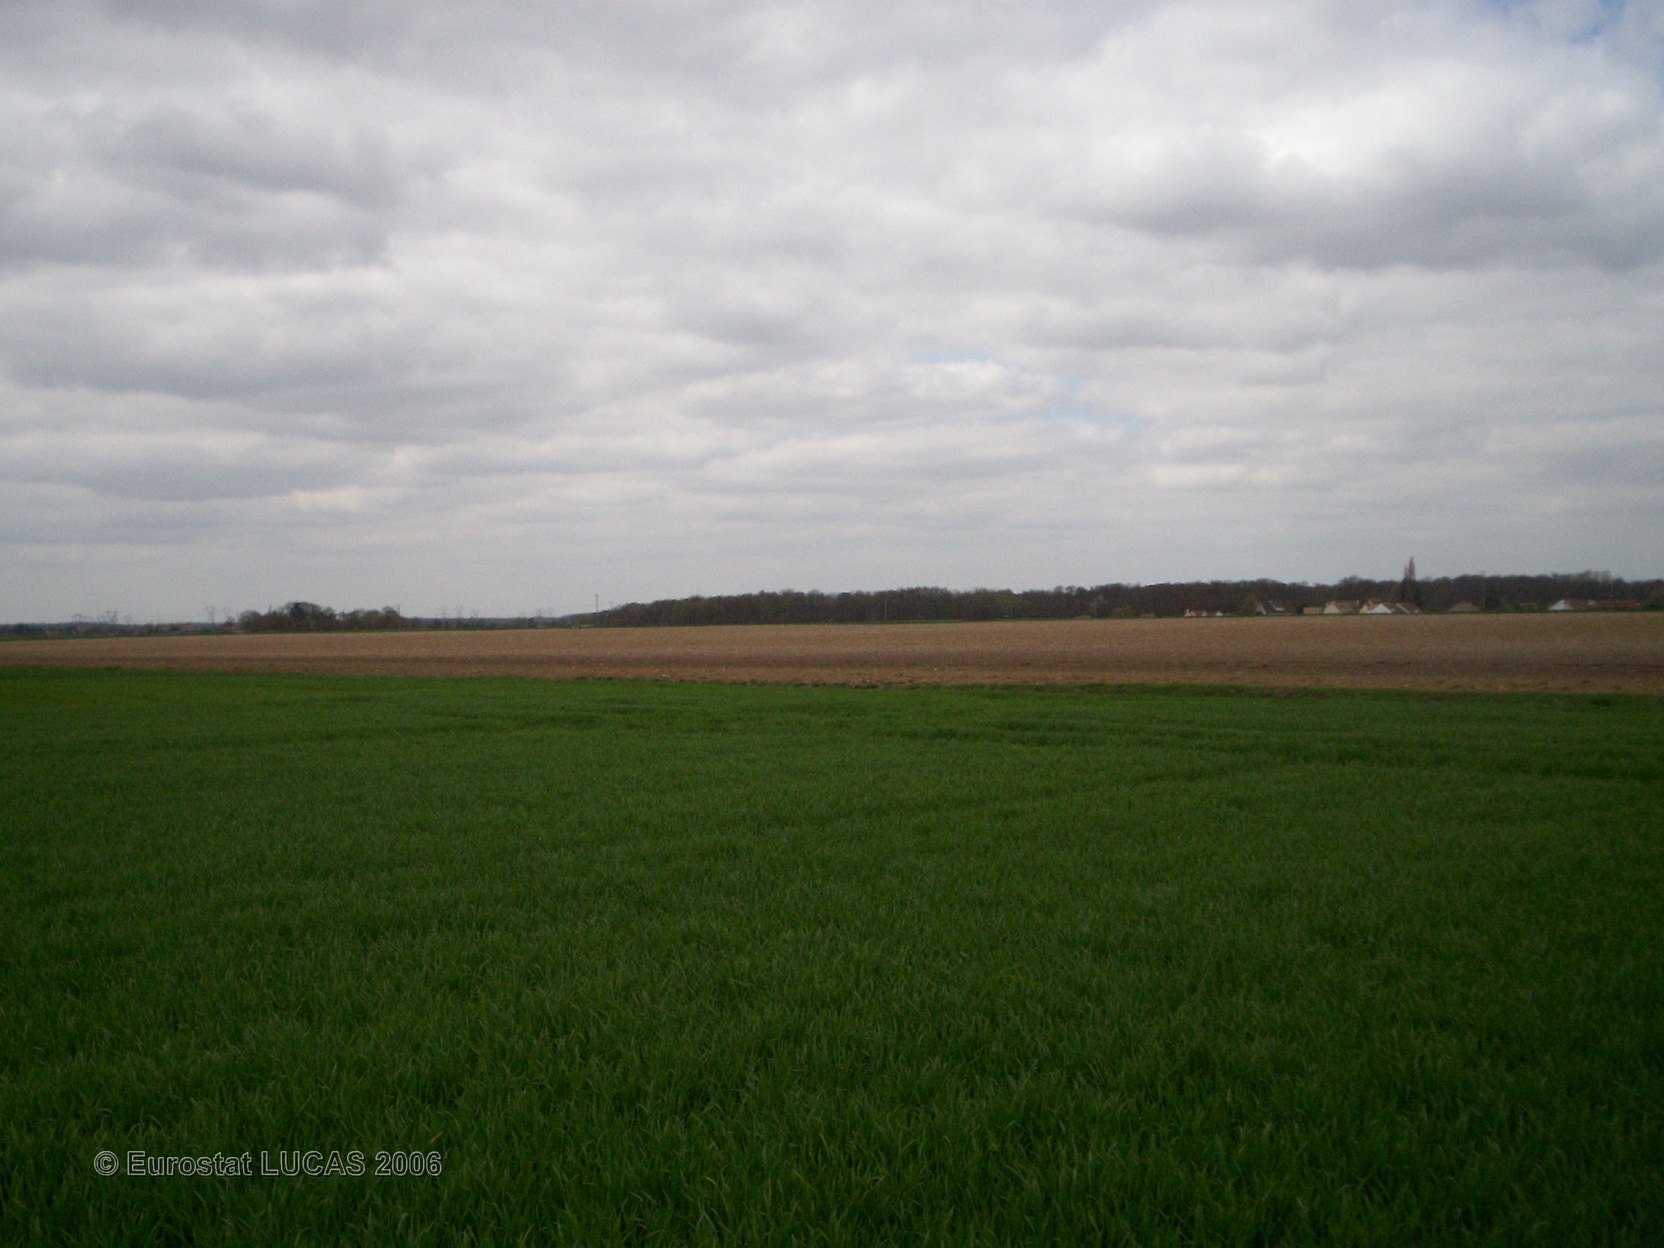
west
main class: Cropland
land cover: Common wheat
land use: Agriculture (excluding fallow land and kitchen gardens)
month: April
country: FR
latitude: 48.4976
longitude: 2.8593
